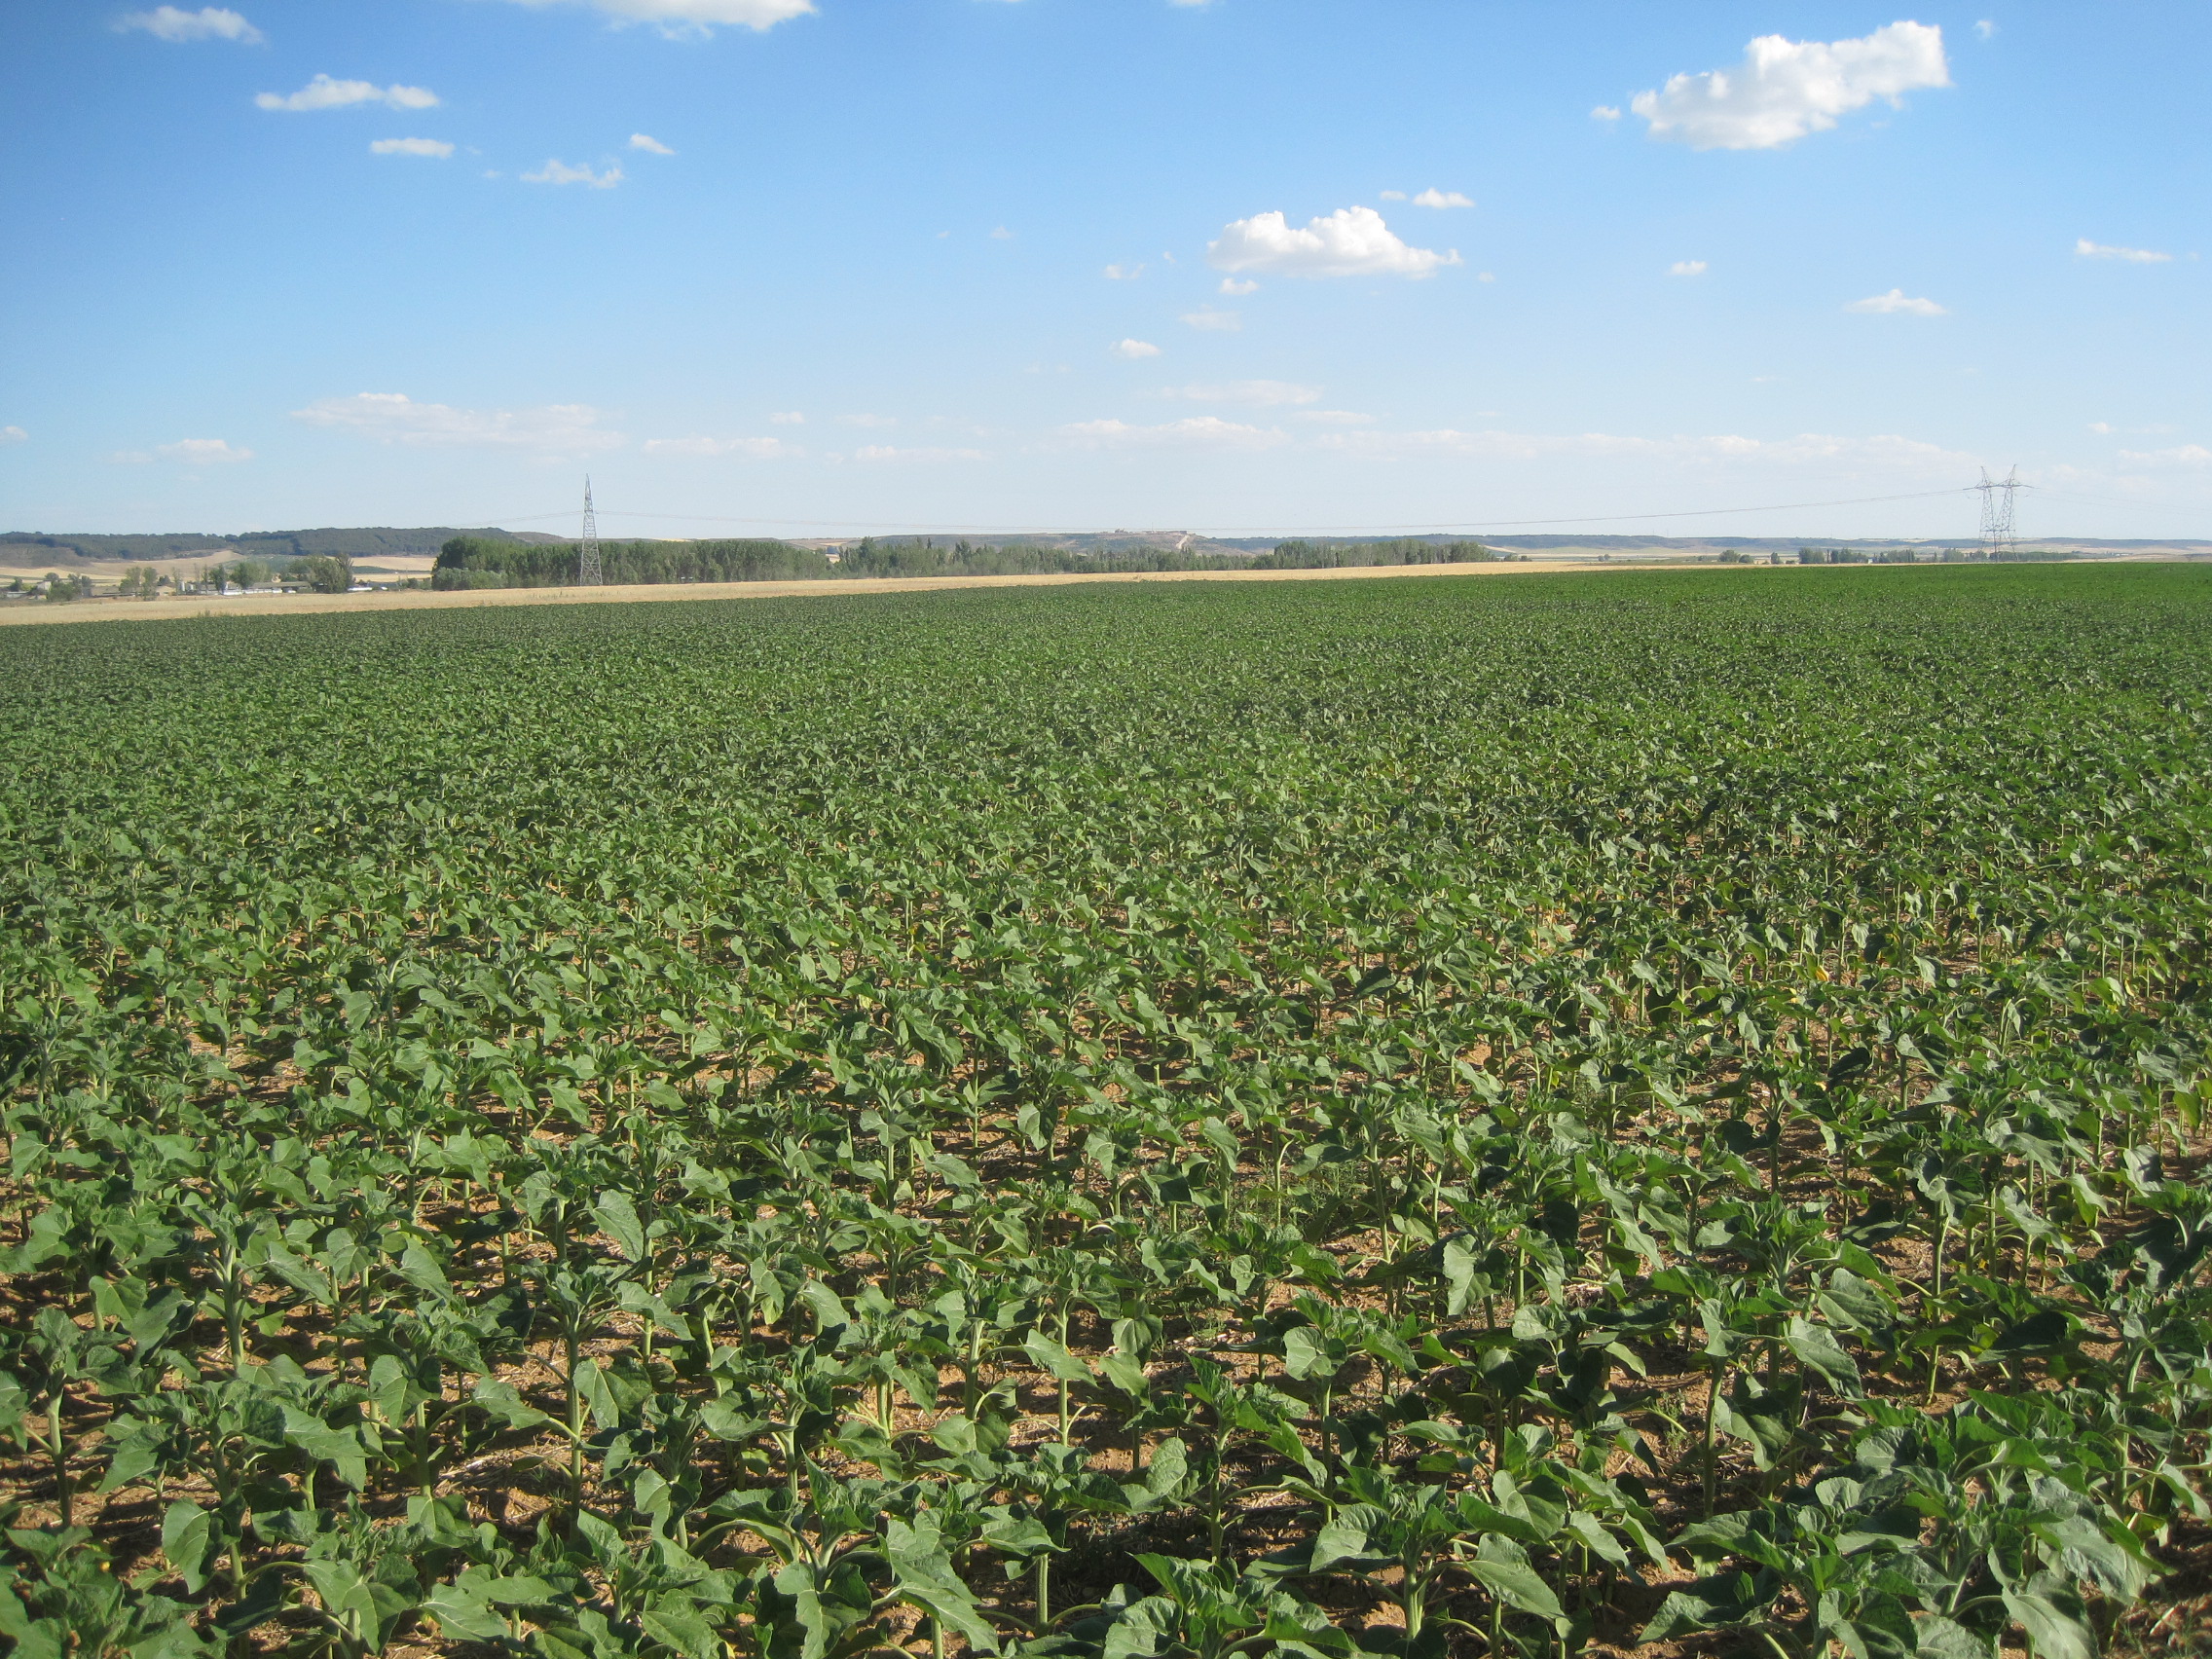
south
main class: Cropland
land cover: Sunflower
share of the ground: > 75 %
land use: Agriculture (excluding fallow land and kitchen gardens)
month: June
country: ES
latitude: 41.7917
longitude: -5.2059
